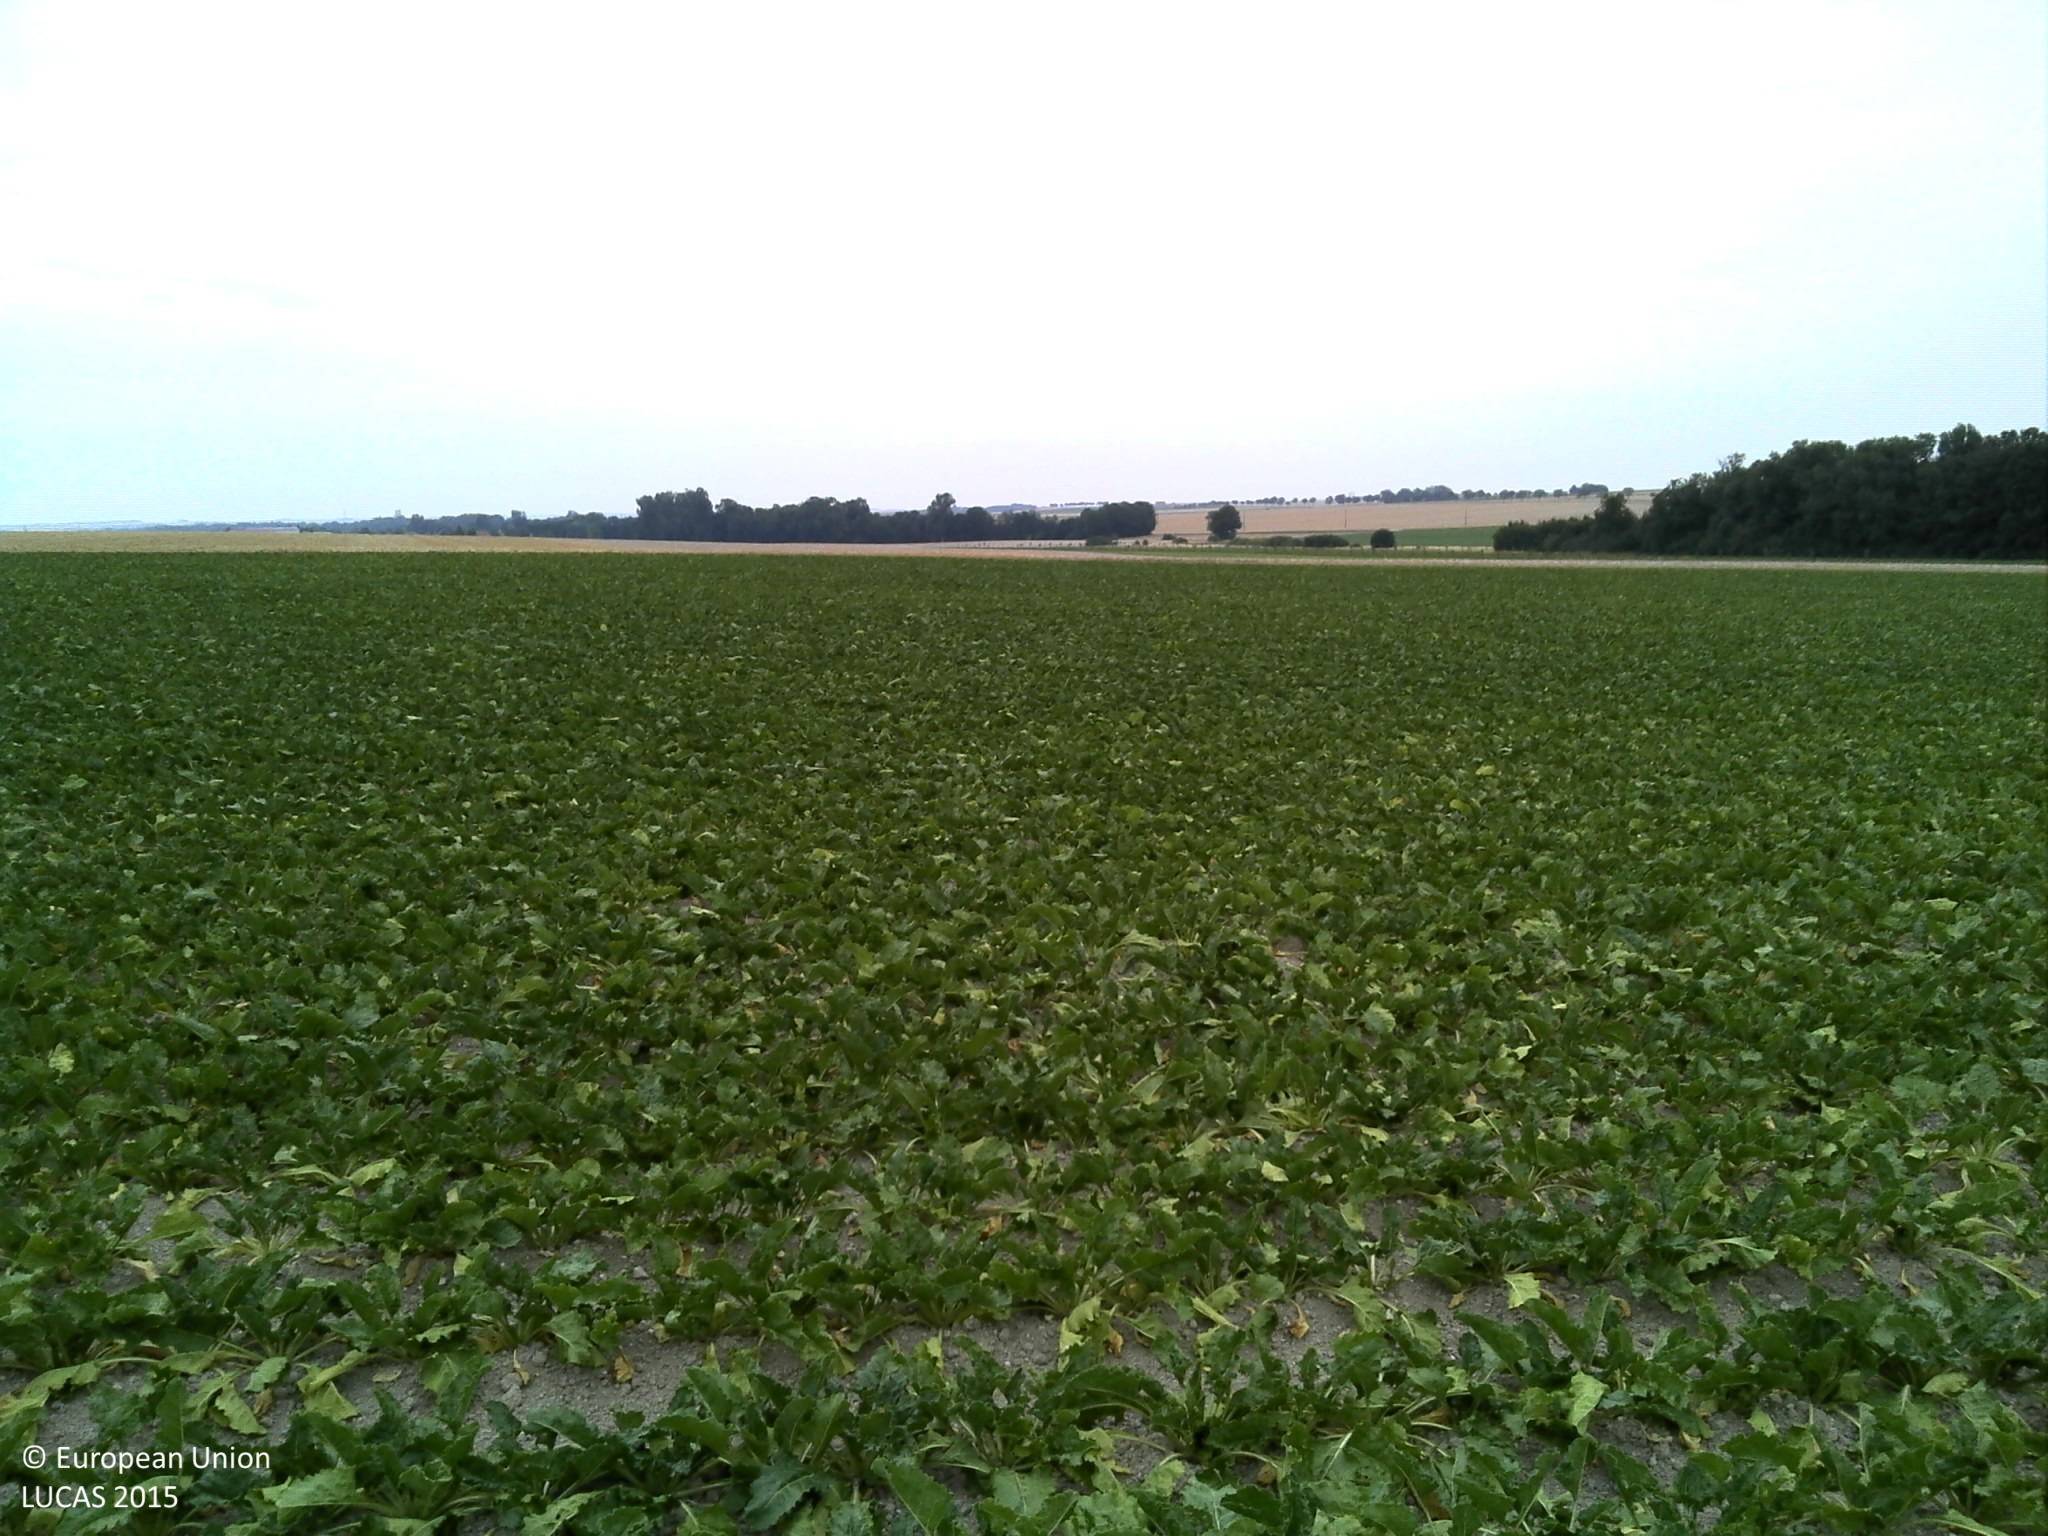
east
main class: Cropland
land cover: Sugar beet
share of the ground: 50 - 75 %
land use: Agriculture (excluding fallow land and kitchen gardens)
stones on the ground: < 10 %
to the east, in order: Sugar beet; Grass margins; Tracks; Grass margins; Rape and turnip rape
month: August
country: FR
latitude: 48.9378
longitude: 4.2212
